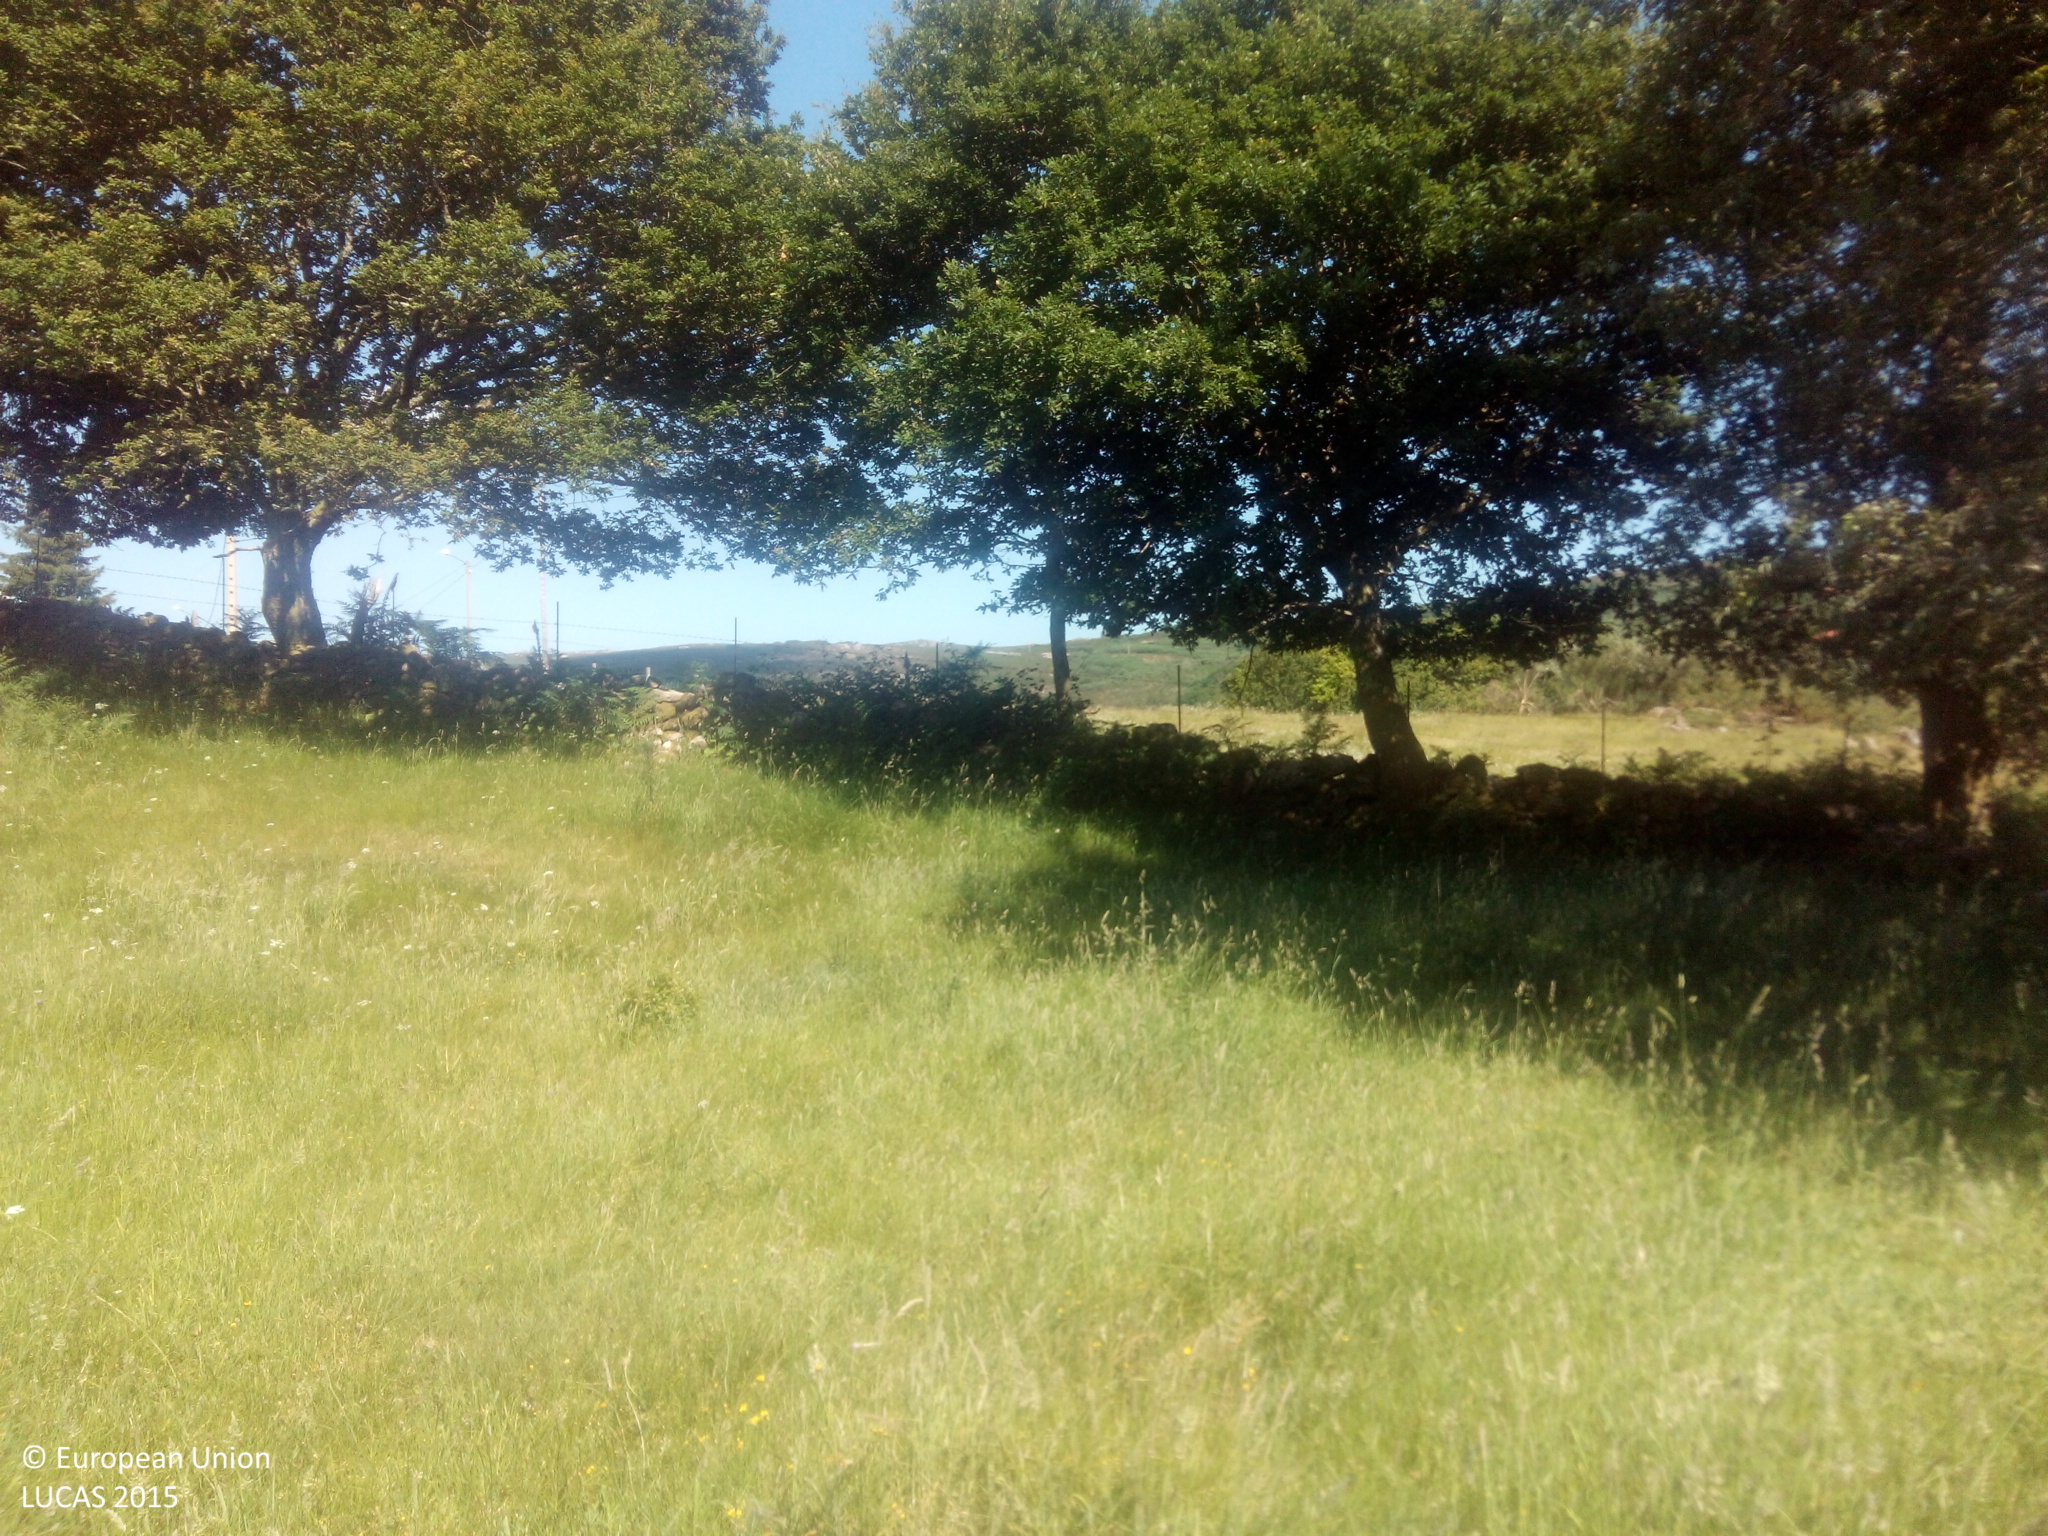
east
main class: Grassland
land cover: Grassland without tree/shrub cover
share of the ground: > 75 %
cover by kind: herbaceous plants 100 %
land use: Agriculture (excluding fallow land and kitchen gardens)
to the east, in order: Grassland without tree/shrub cover; Lines of trees; Dry stone walls; Fences; Grassland without tree/shrub cover; Electric lines; Fences; Grass margins; Paved roads, cycling and walking lanes; Grass margins; Artificial constructions in urban areas; Grassland without tree/shrub cover; Artificial constructions in urban areas; Grassland without tree/shrub cover; Artificial constructions in urban areas; Grassland without tree/shrub cover; Dry stone walls; Tracks; Dry stone walls; Broadleaved woodland
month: June
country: ES
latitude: 42.4313
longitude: -8.3874
